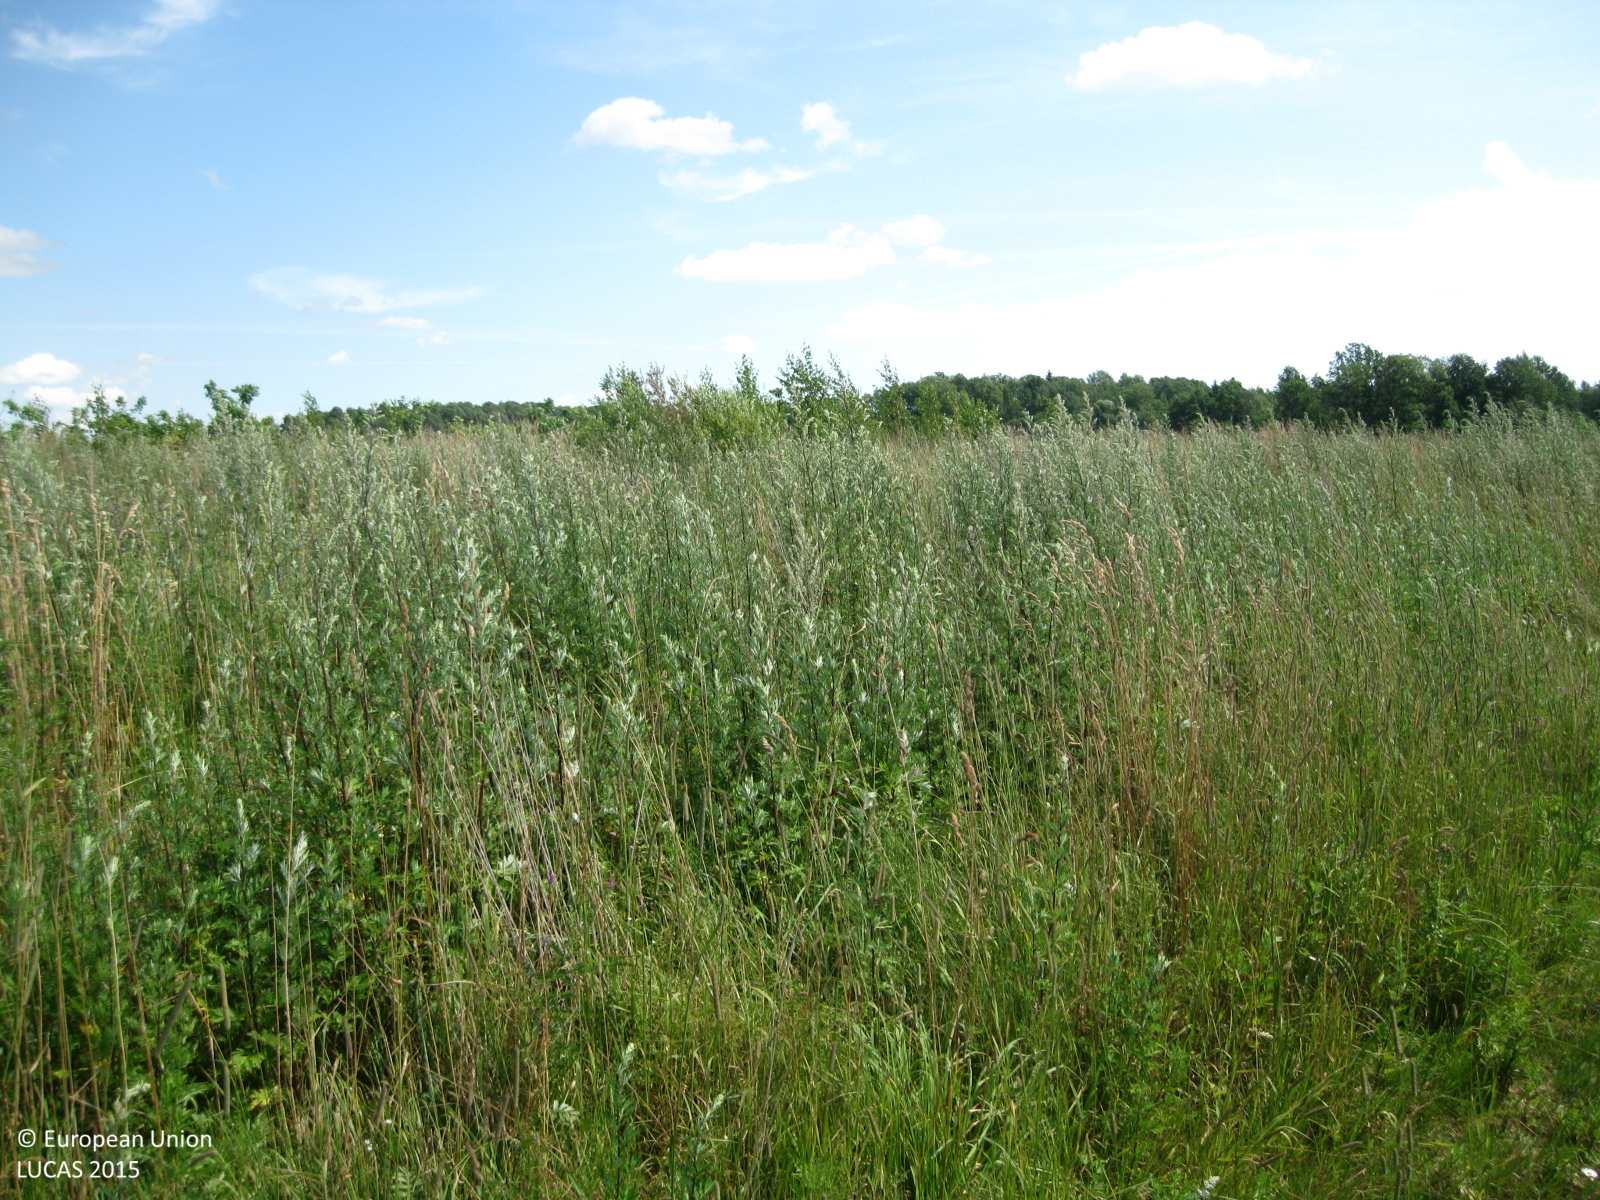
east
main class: Cropland
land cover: Dry pulses
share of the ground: > 75 %
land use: Agriculture (excluding fallow land and kitchen gardens)
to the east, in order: Dry pulses; Spontaneously vegetated surfaces; Broadleaved woodland; Grass margins; Paved roads, cycling and walking lanes; Grass margins; Dry pulses; Grassland without tree/shrub cover; Dry pulses
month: July
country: LT
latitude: 55.0867
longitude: 24.6275
